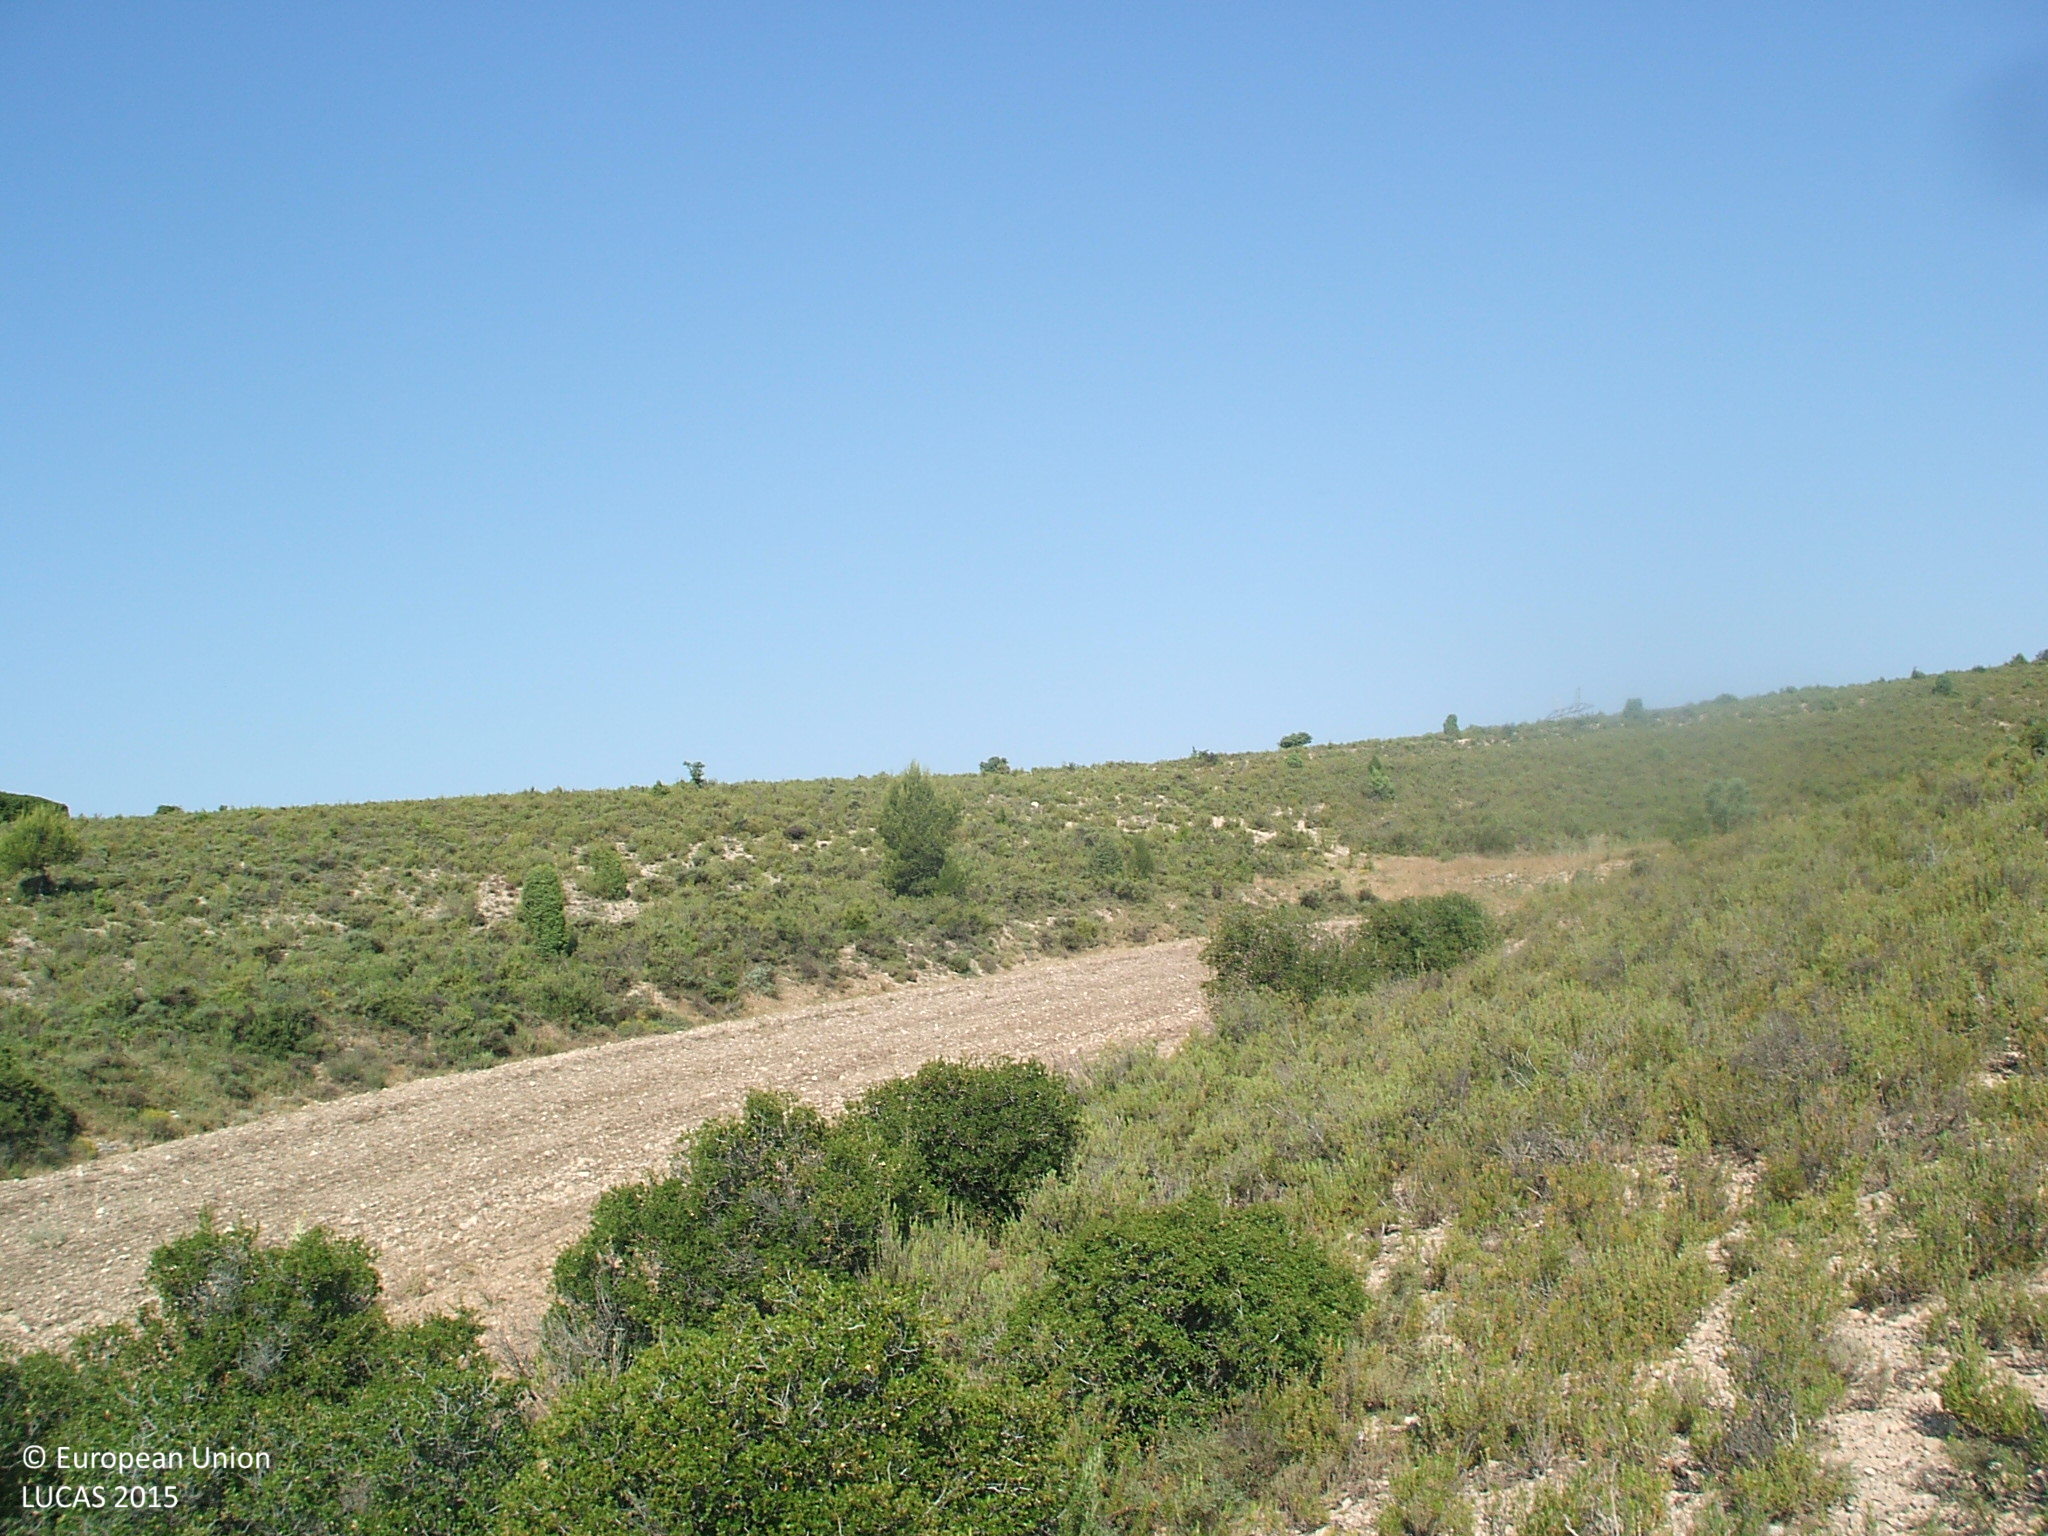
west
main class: Shrubland
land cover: Shrubland without tree cover
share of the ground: 50 - 75 %
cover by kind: shrubs 70 %, consolidated bare surface 30 %
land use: Semi-natural and natural areas not in use
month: June
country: ES
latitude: 40.8792
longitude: -0.2277
